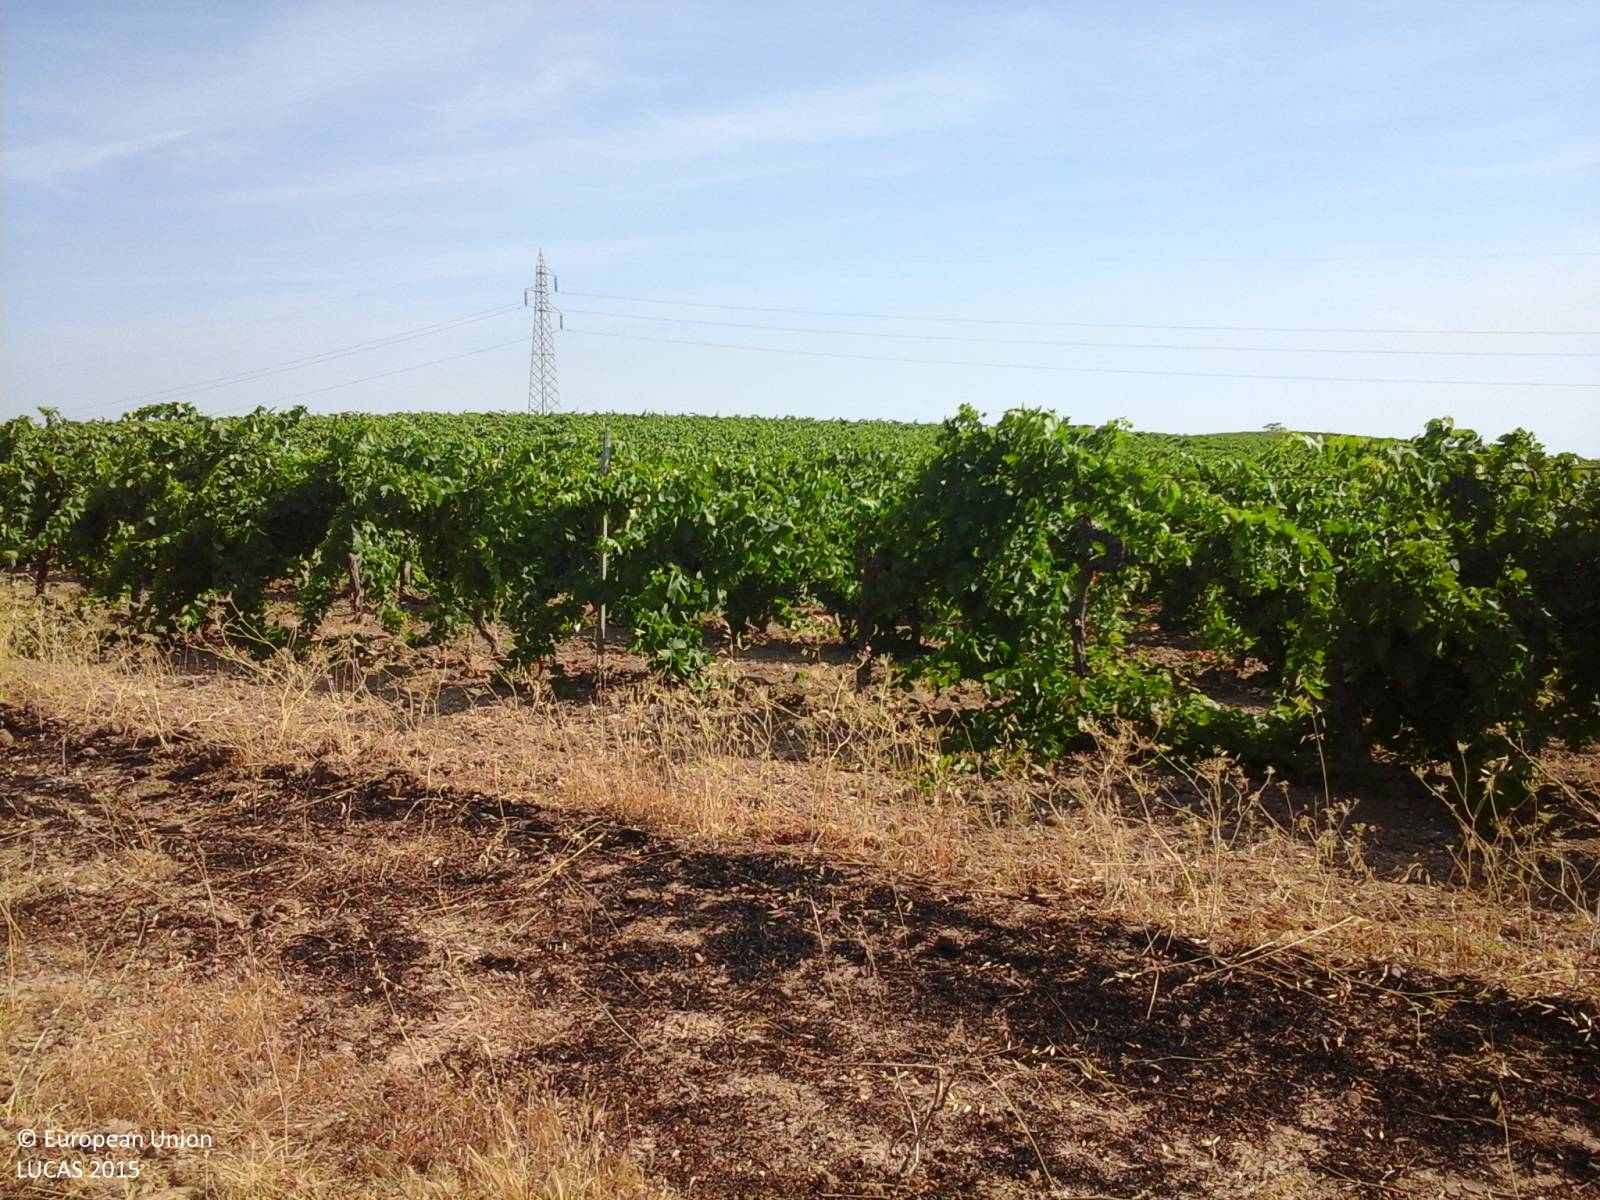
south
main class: Cropland
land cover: Vineyards
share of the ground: 50 - 75 %
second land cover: Other bare soil
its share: > 75 %
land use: Agriculture (excluding fallow land and kitchen gardens)
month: June
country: IT
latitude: 37.8190
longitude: 12.6725
